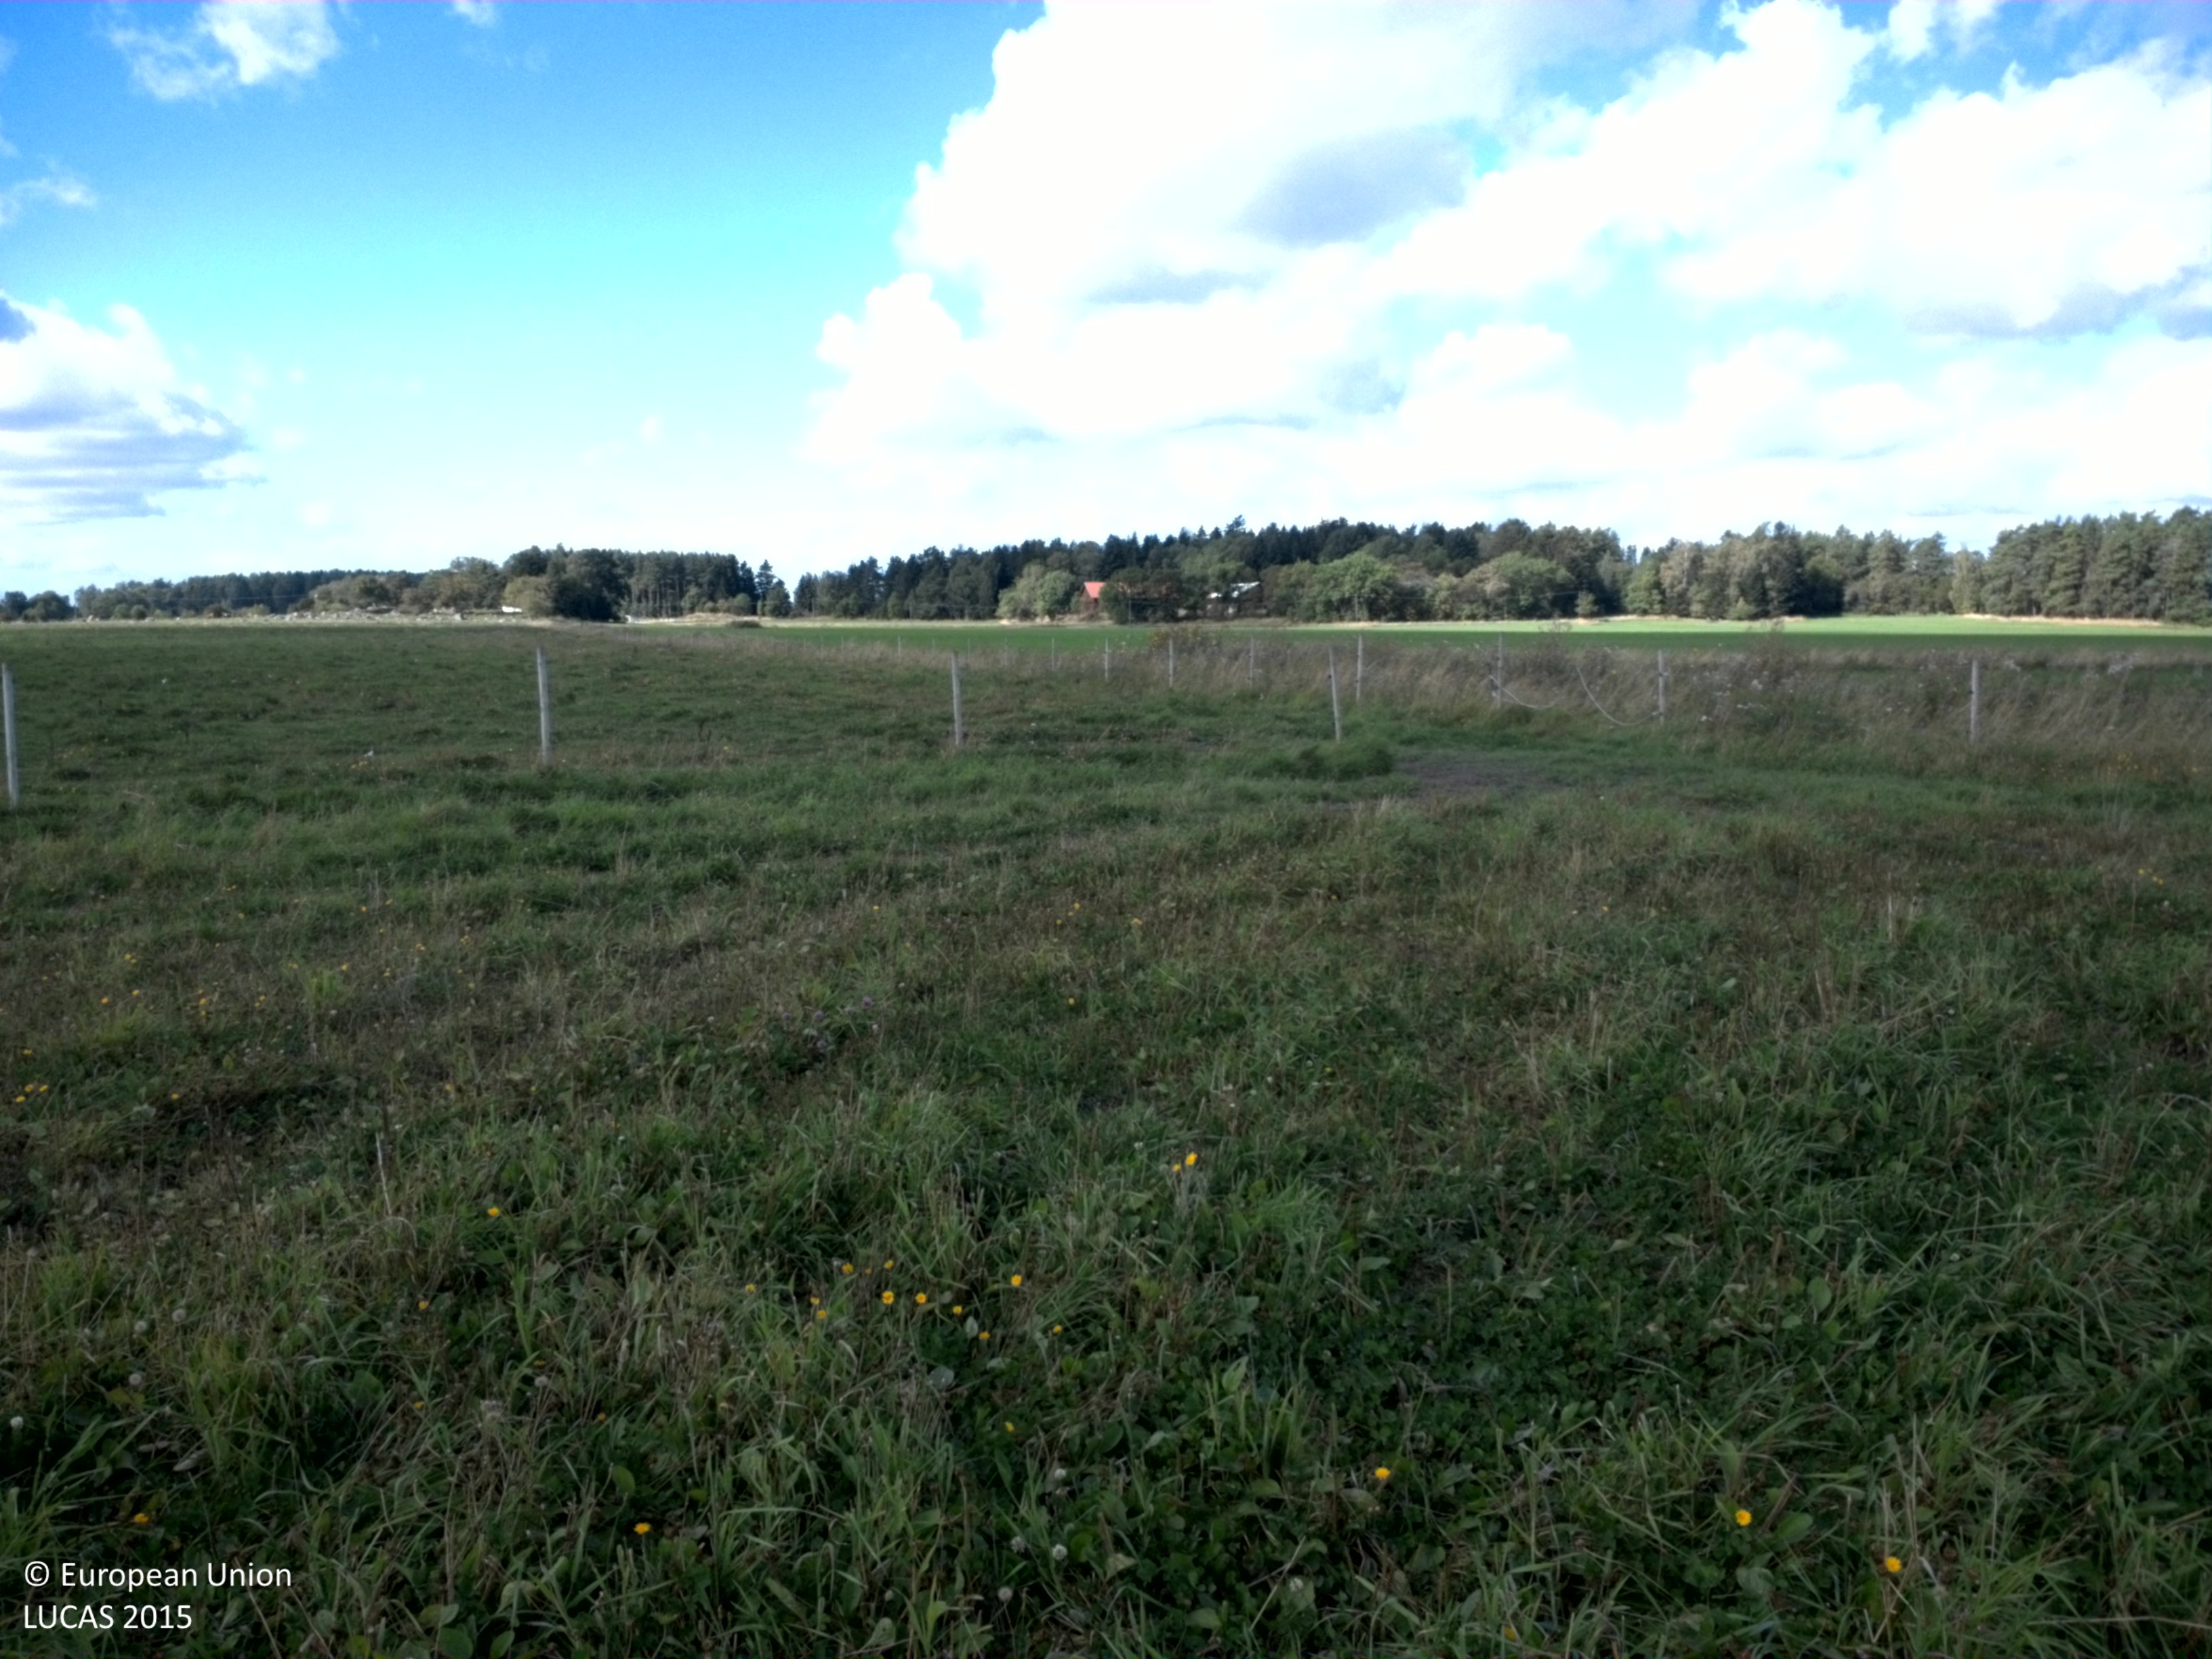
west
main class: Grassland
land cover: Grassland without tree/shrub cover
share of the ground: > 75 %
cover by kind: herbaceous plants 100 %
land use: Agriculture (excluding fallow land and kitchen gardens)
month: August
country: SE
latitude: 59.7007
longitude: 16.9764
